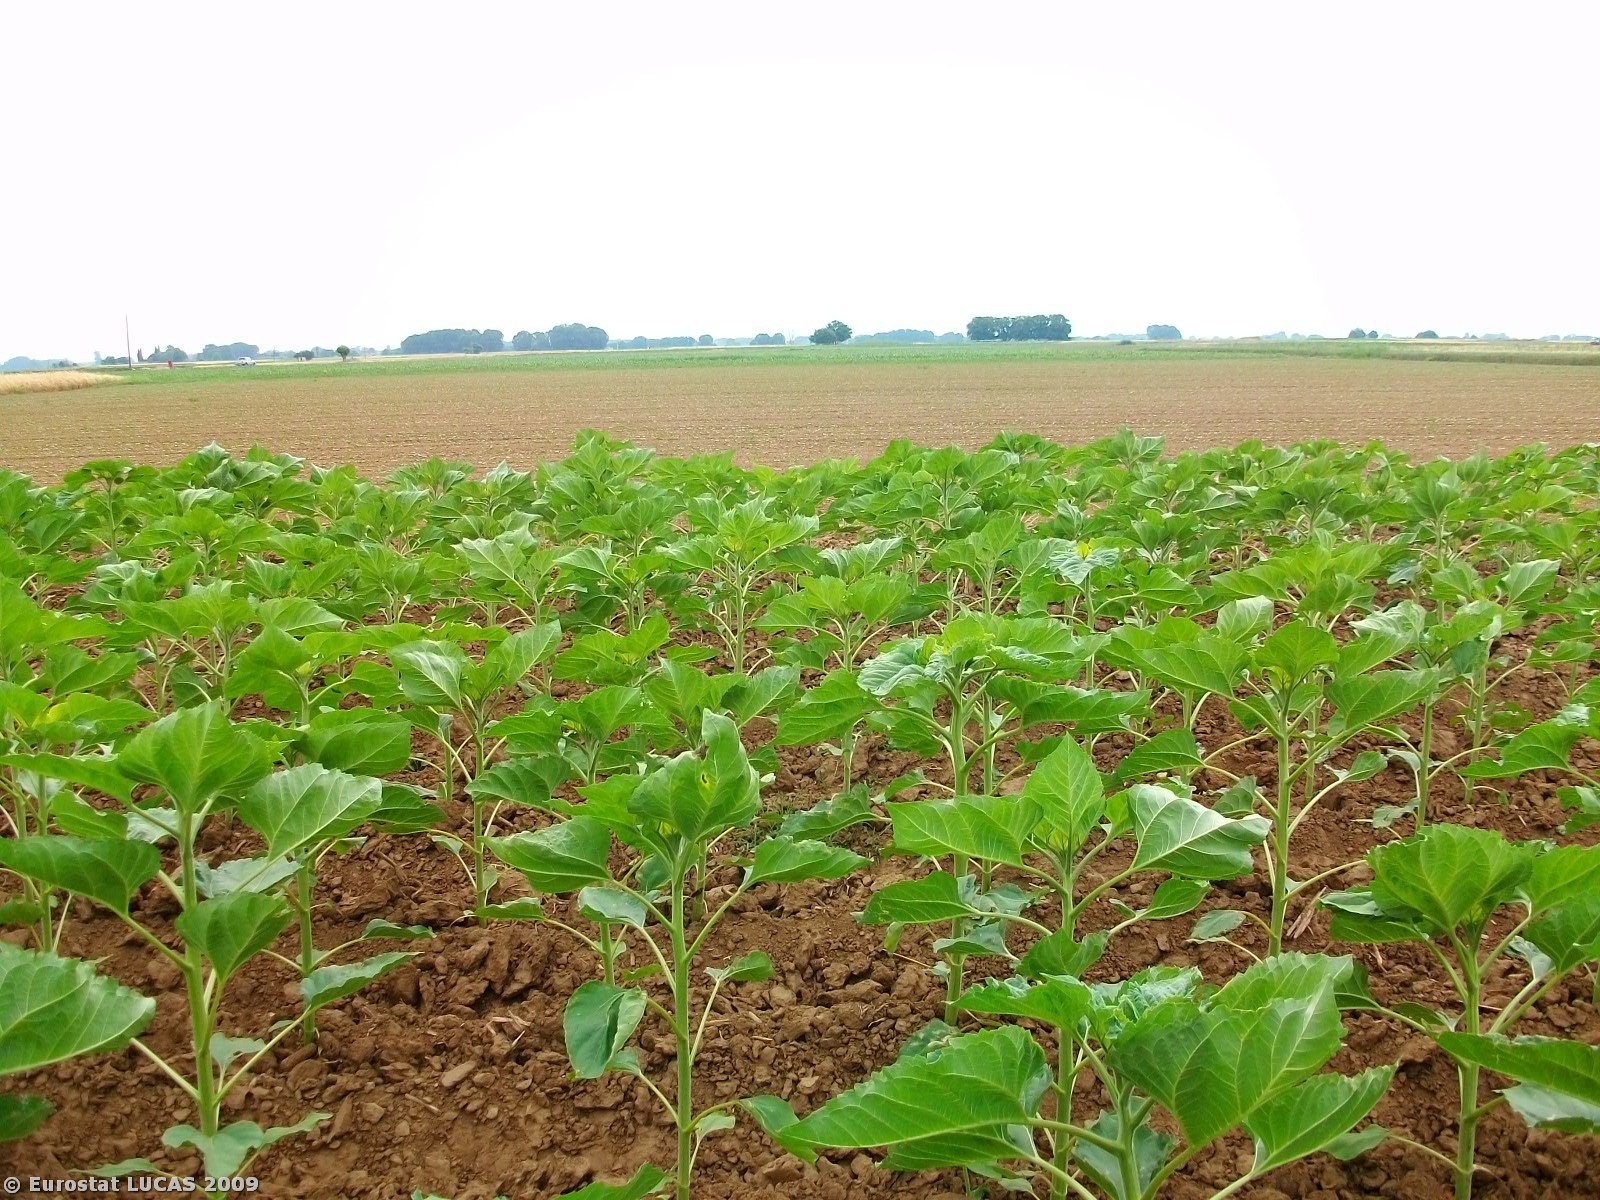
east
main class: Cropland
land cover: Sunflower
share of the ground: > 75 %
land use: Agriculture (excluding fallow land and kitchen gardens)
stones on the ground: < 10 %
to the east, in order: Sunflower; Cotton; Tracks; Maize; Tracks; Cotton
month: June
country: GR
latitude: 41.0476
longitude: 25.5058
